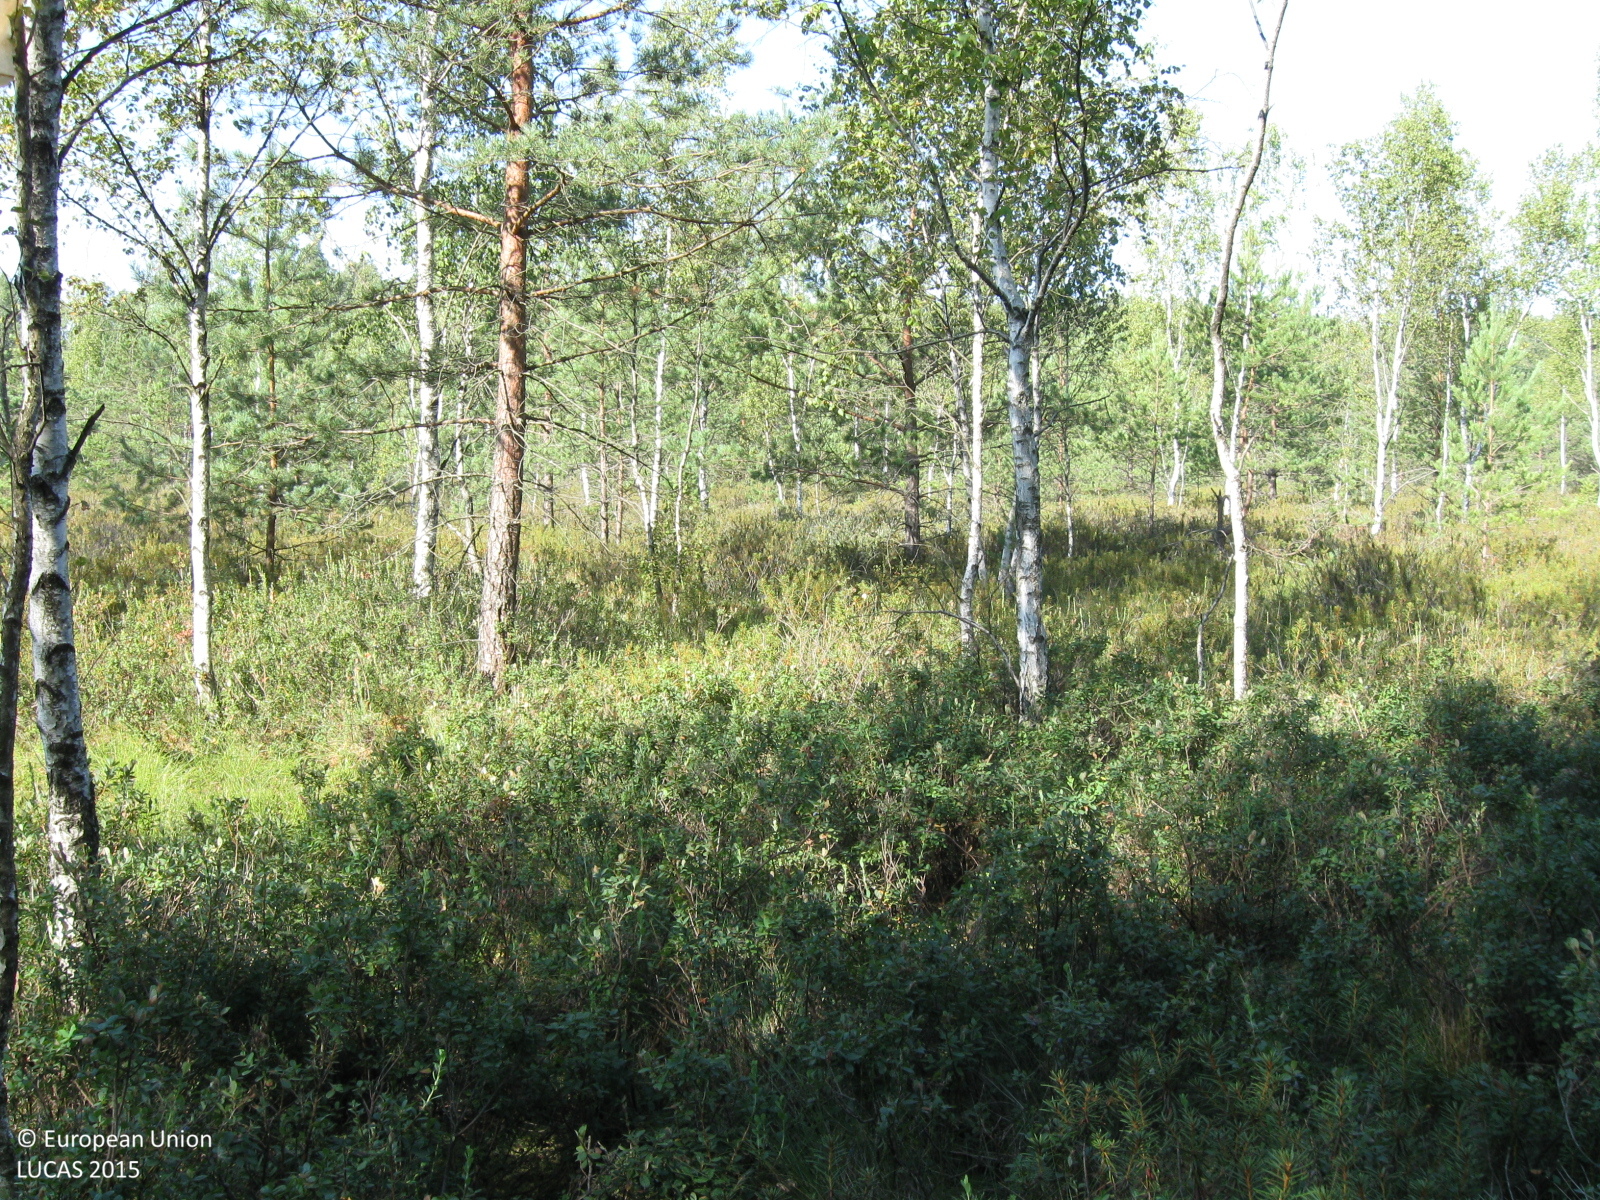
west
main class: Woodland
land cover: Pine dominated mixed woodland
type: mire and swamp forests
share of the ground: 50 - 75 %
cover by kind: broadleaved forest trees 35 %, shrubs 35 %, coniferous forest trees 15 %, herbaceous plants 10 %, lichens and mosses 5 %
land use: Forestry
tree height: > 5 m
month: August
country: LT
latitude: 55.1288
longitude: 22.7543
